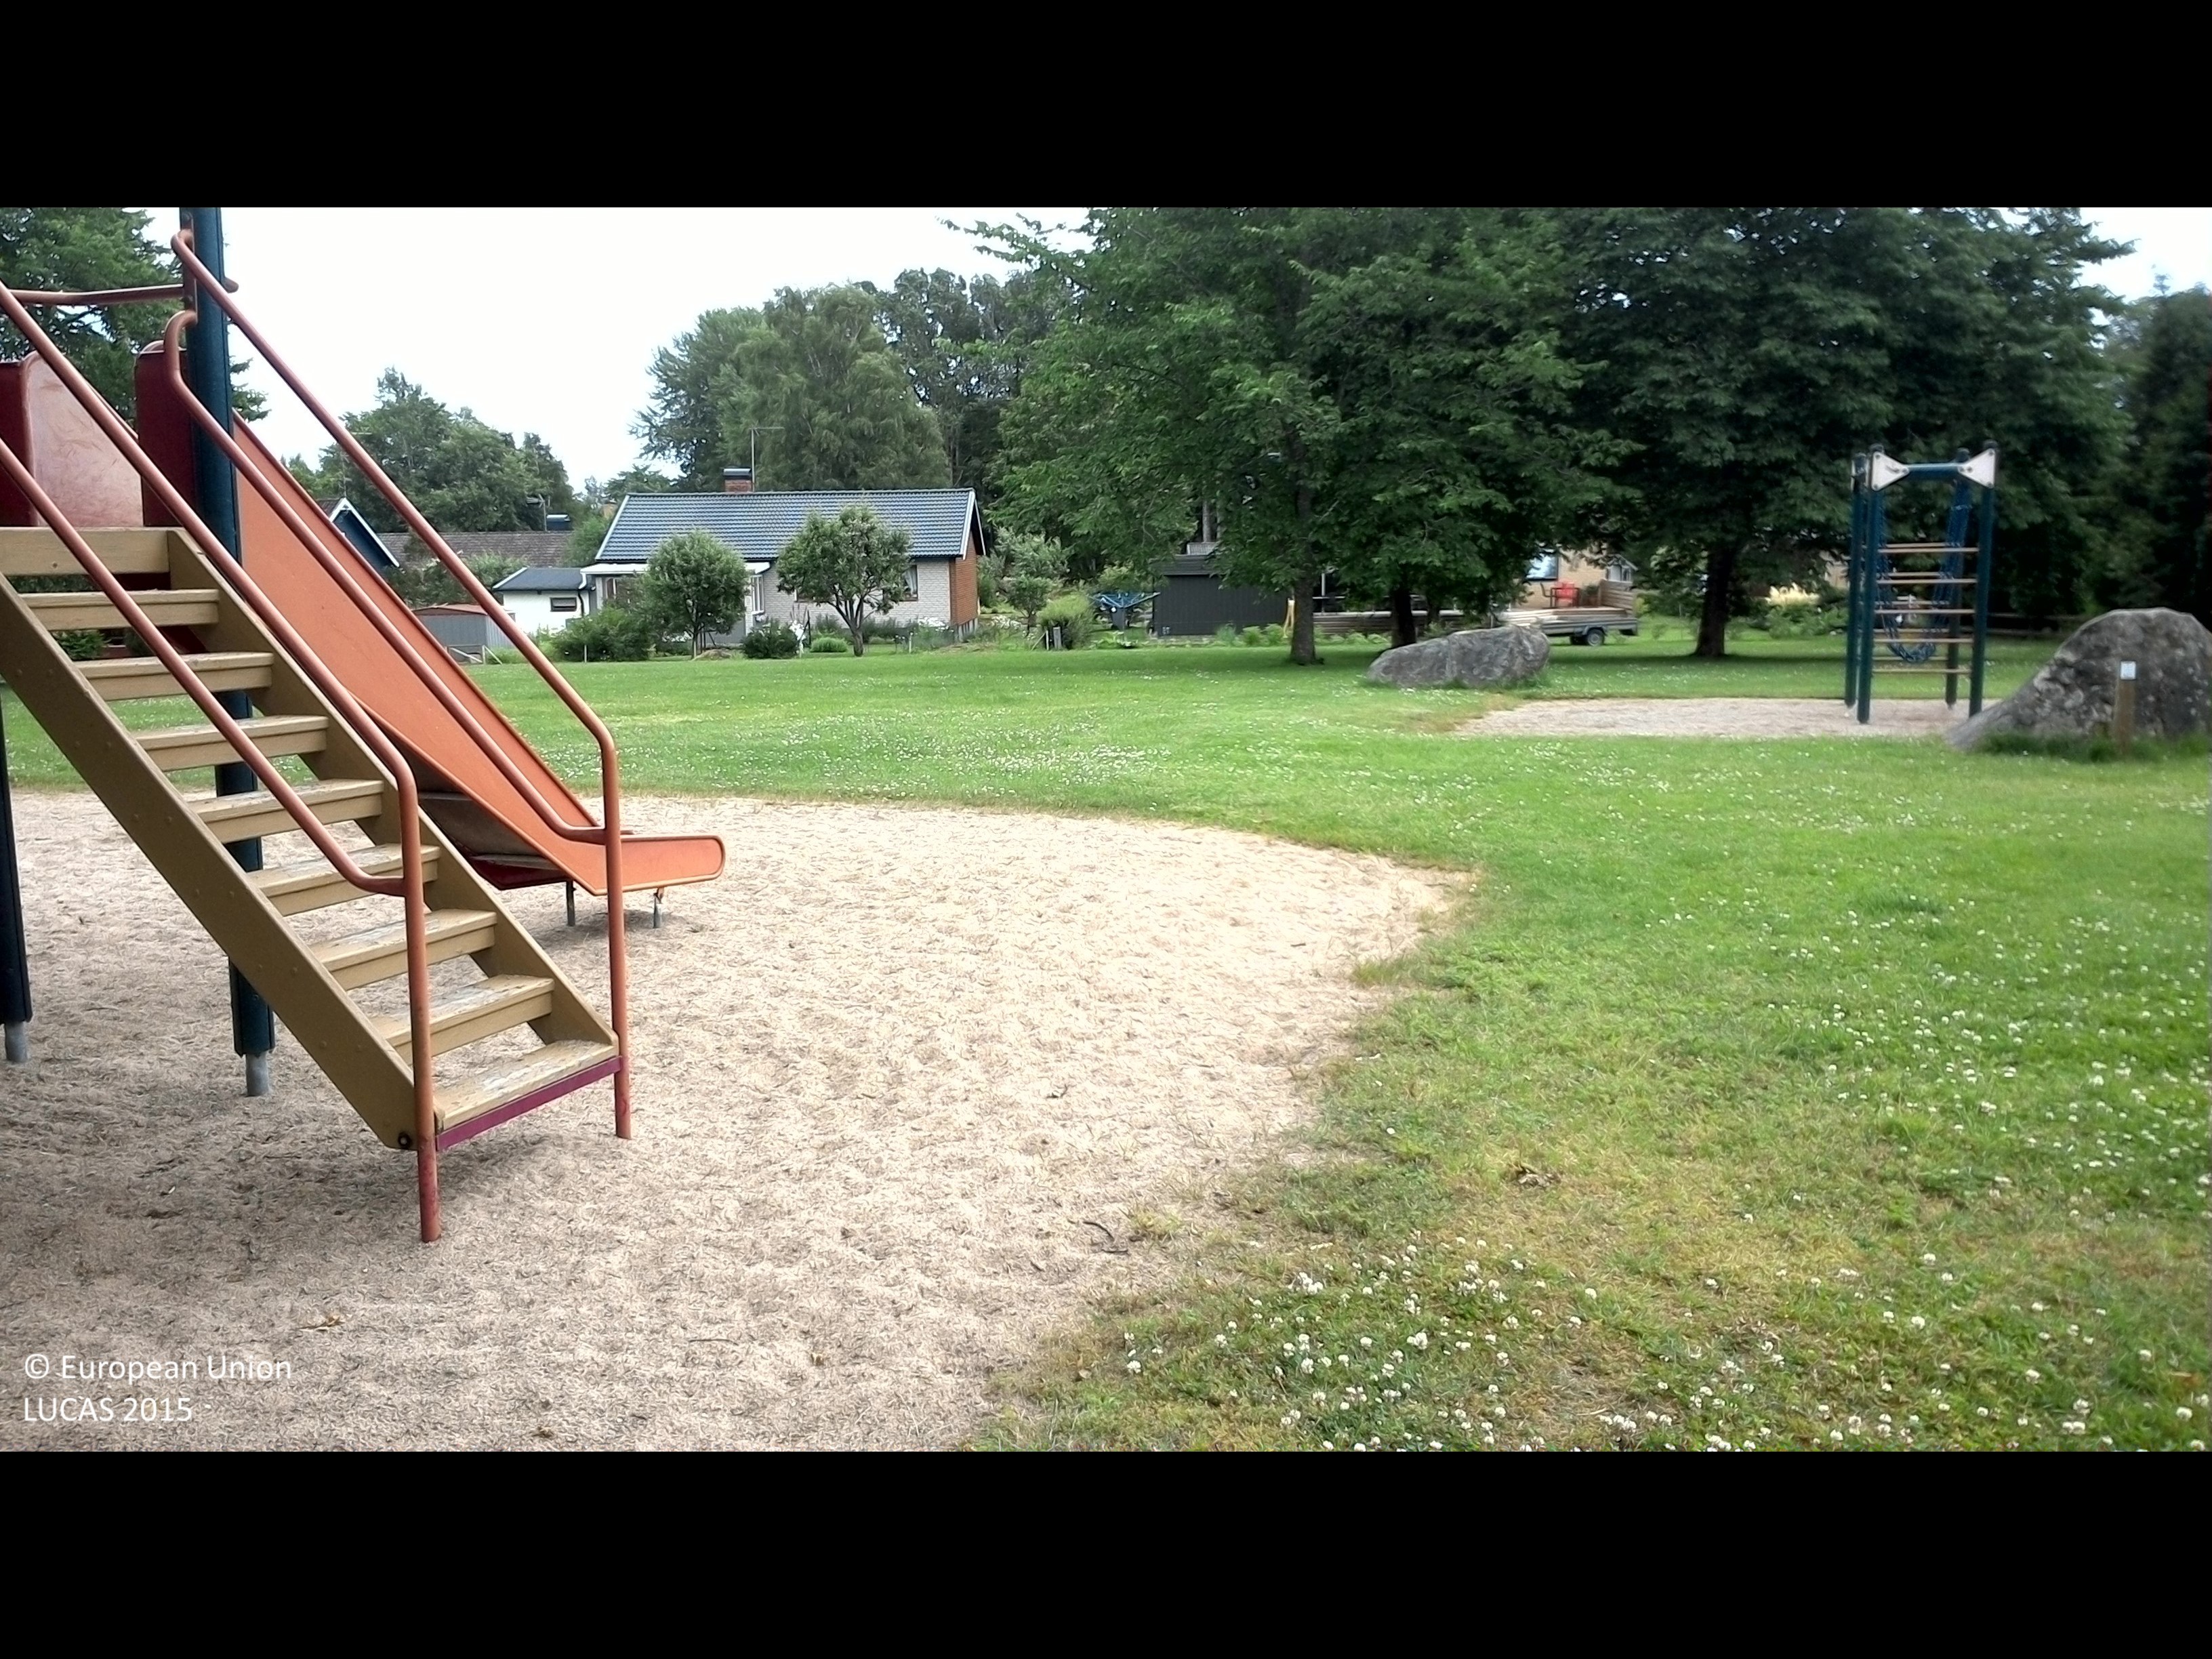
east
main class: Grassland
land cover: Grassland without tree/shrub cover
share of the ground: > 75 %
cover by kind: herbaceous plants 100 %
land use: Amenities, museums, leisure
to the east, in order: Grassland without tree/shrub cover; Artificial constructions in urban areas
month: July
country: SE
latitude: 56.4624
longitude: 14.6880
